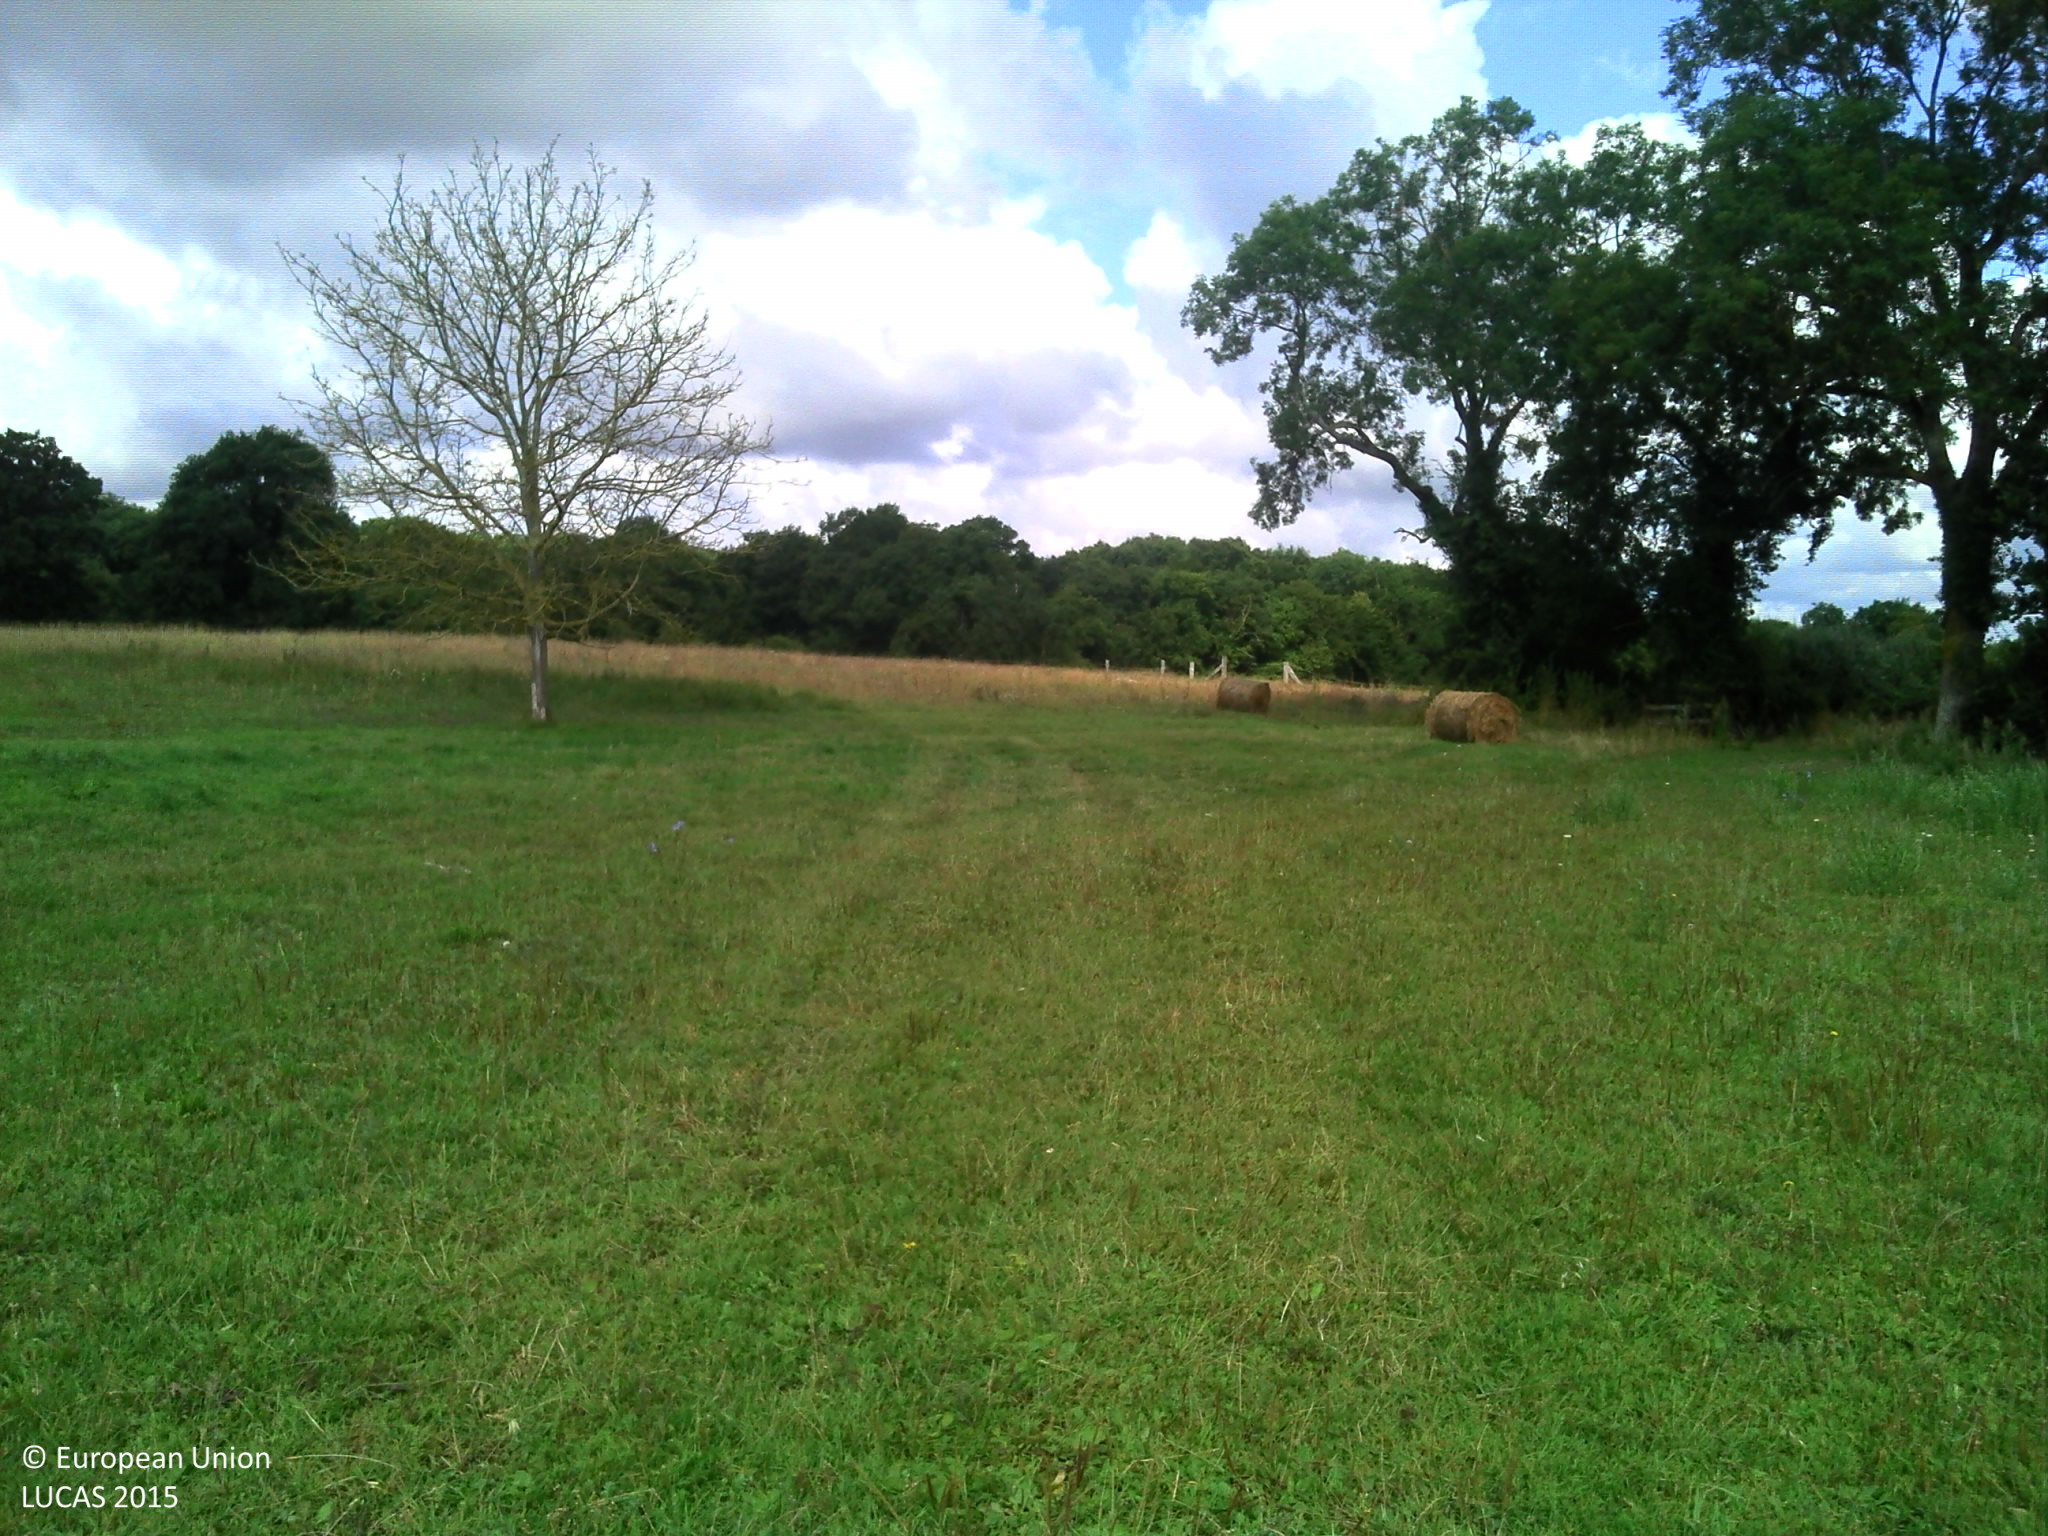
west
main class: Grassland
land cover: Grassland without tree/shrub cover
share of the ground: > 75 %
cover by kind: herbaceous plants 100 %
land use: Agriculture (excluding fallow land and kitchen gardens)
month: July
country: FR
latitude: 48.8769
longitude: -0.1631
